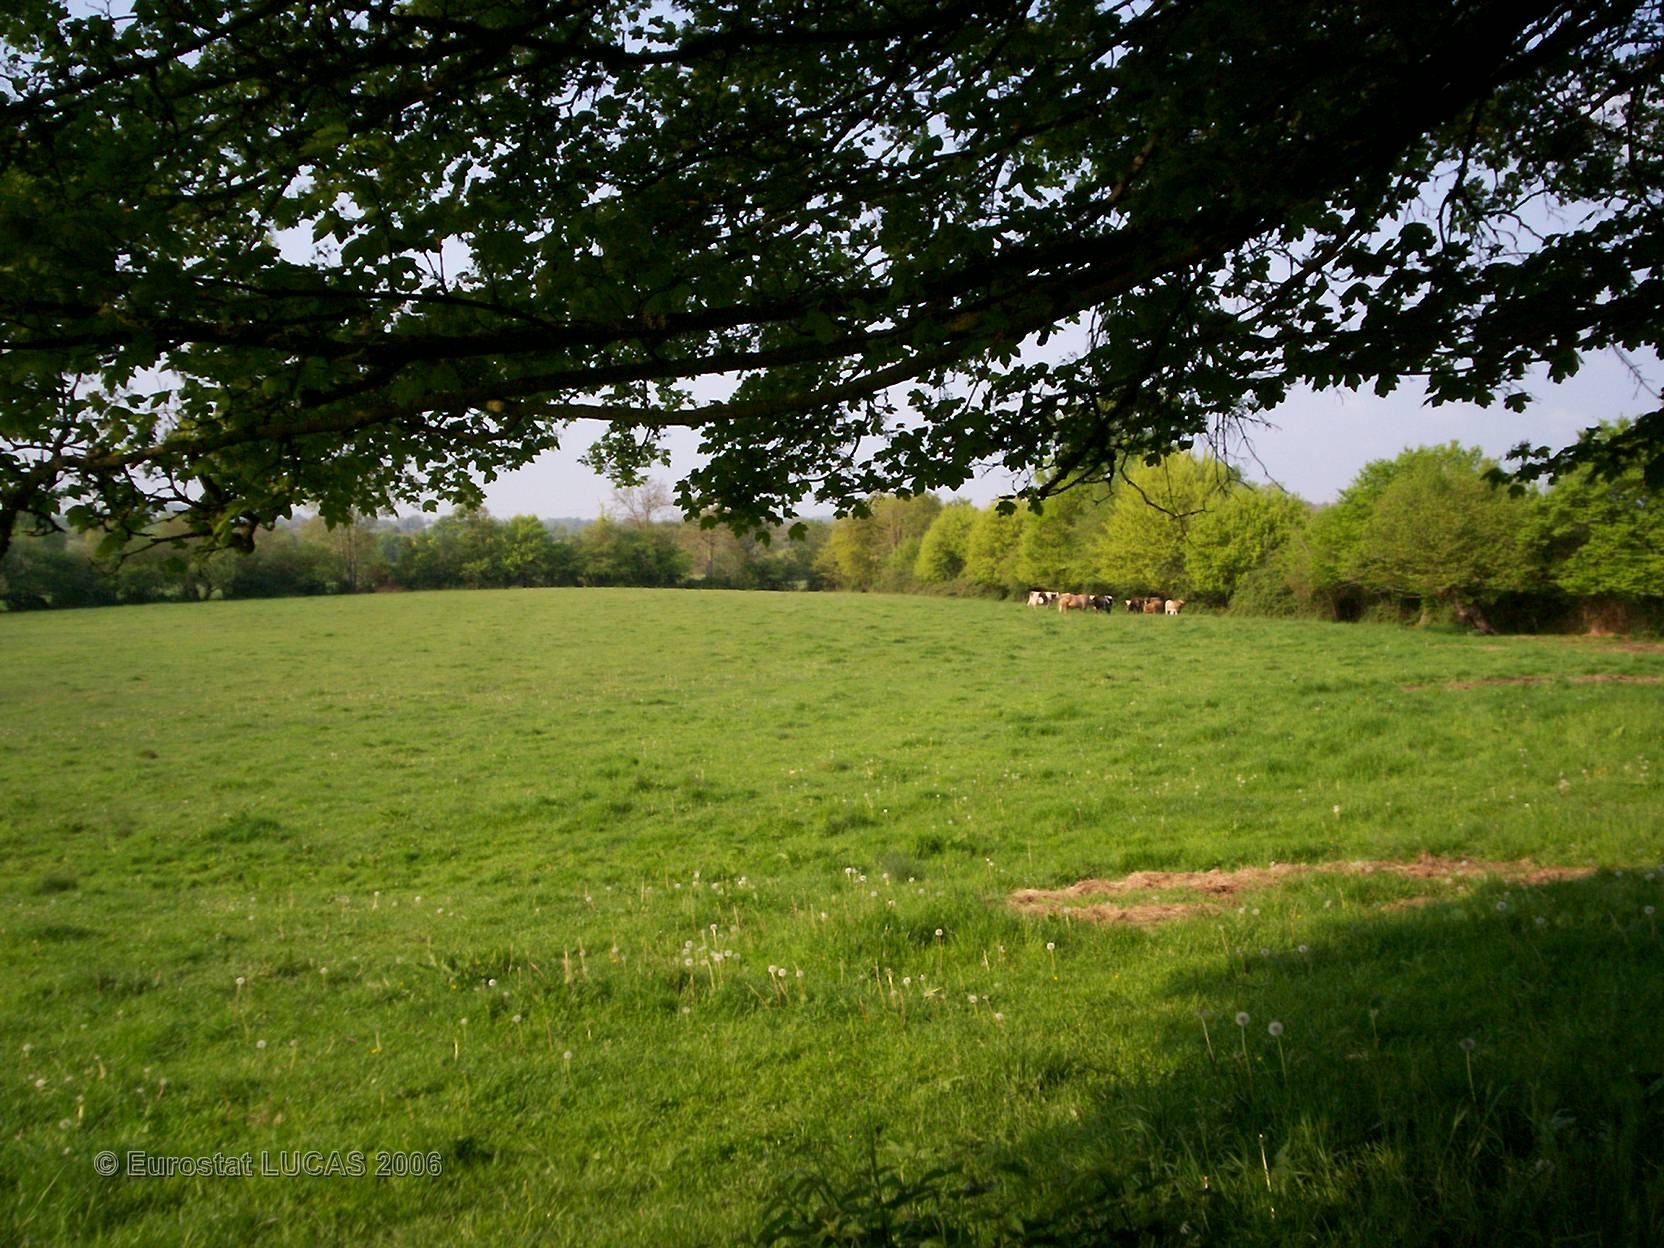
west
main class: Grassland
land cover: Grassland without tree/shrub cover
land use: Agriculture (excluding fallow land and kitchen gardens)
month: May
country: FR
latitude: 48.5903
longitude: 0.2791
